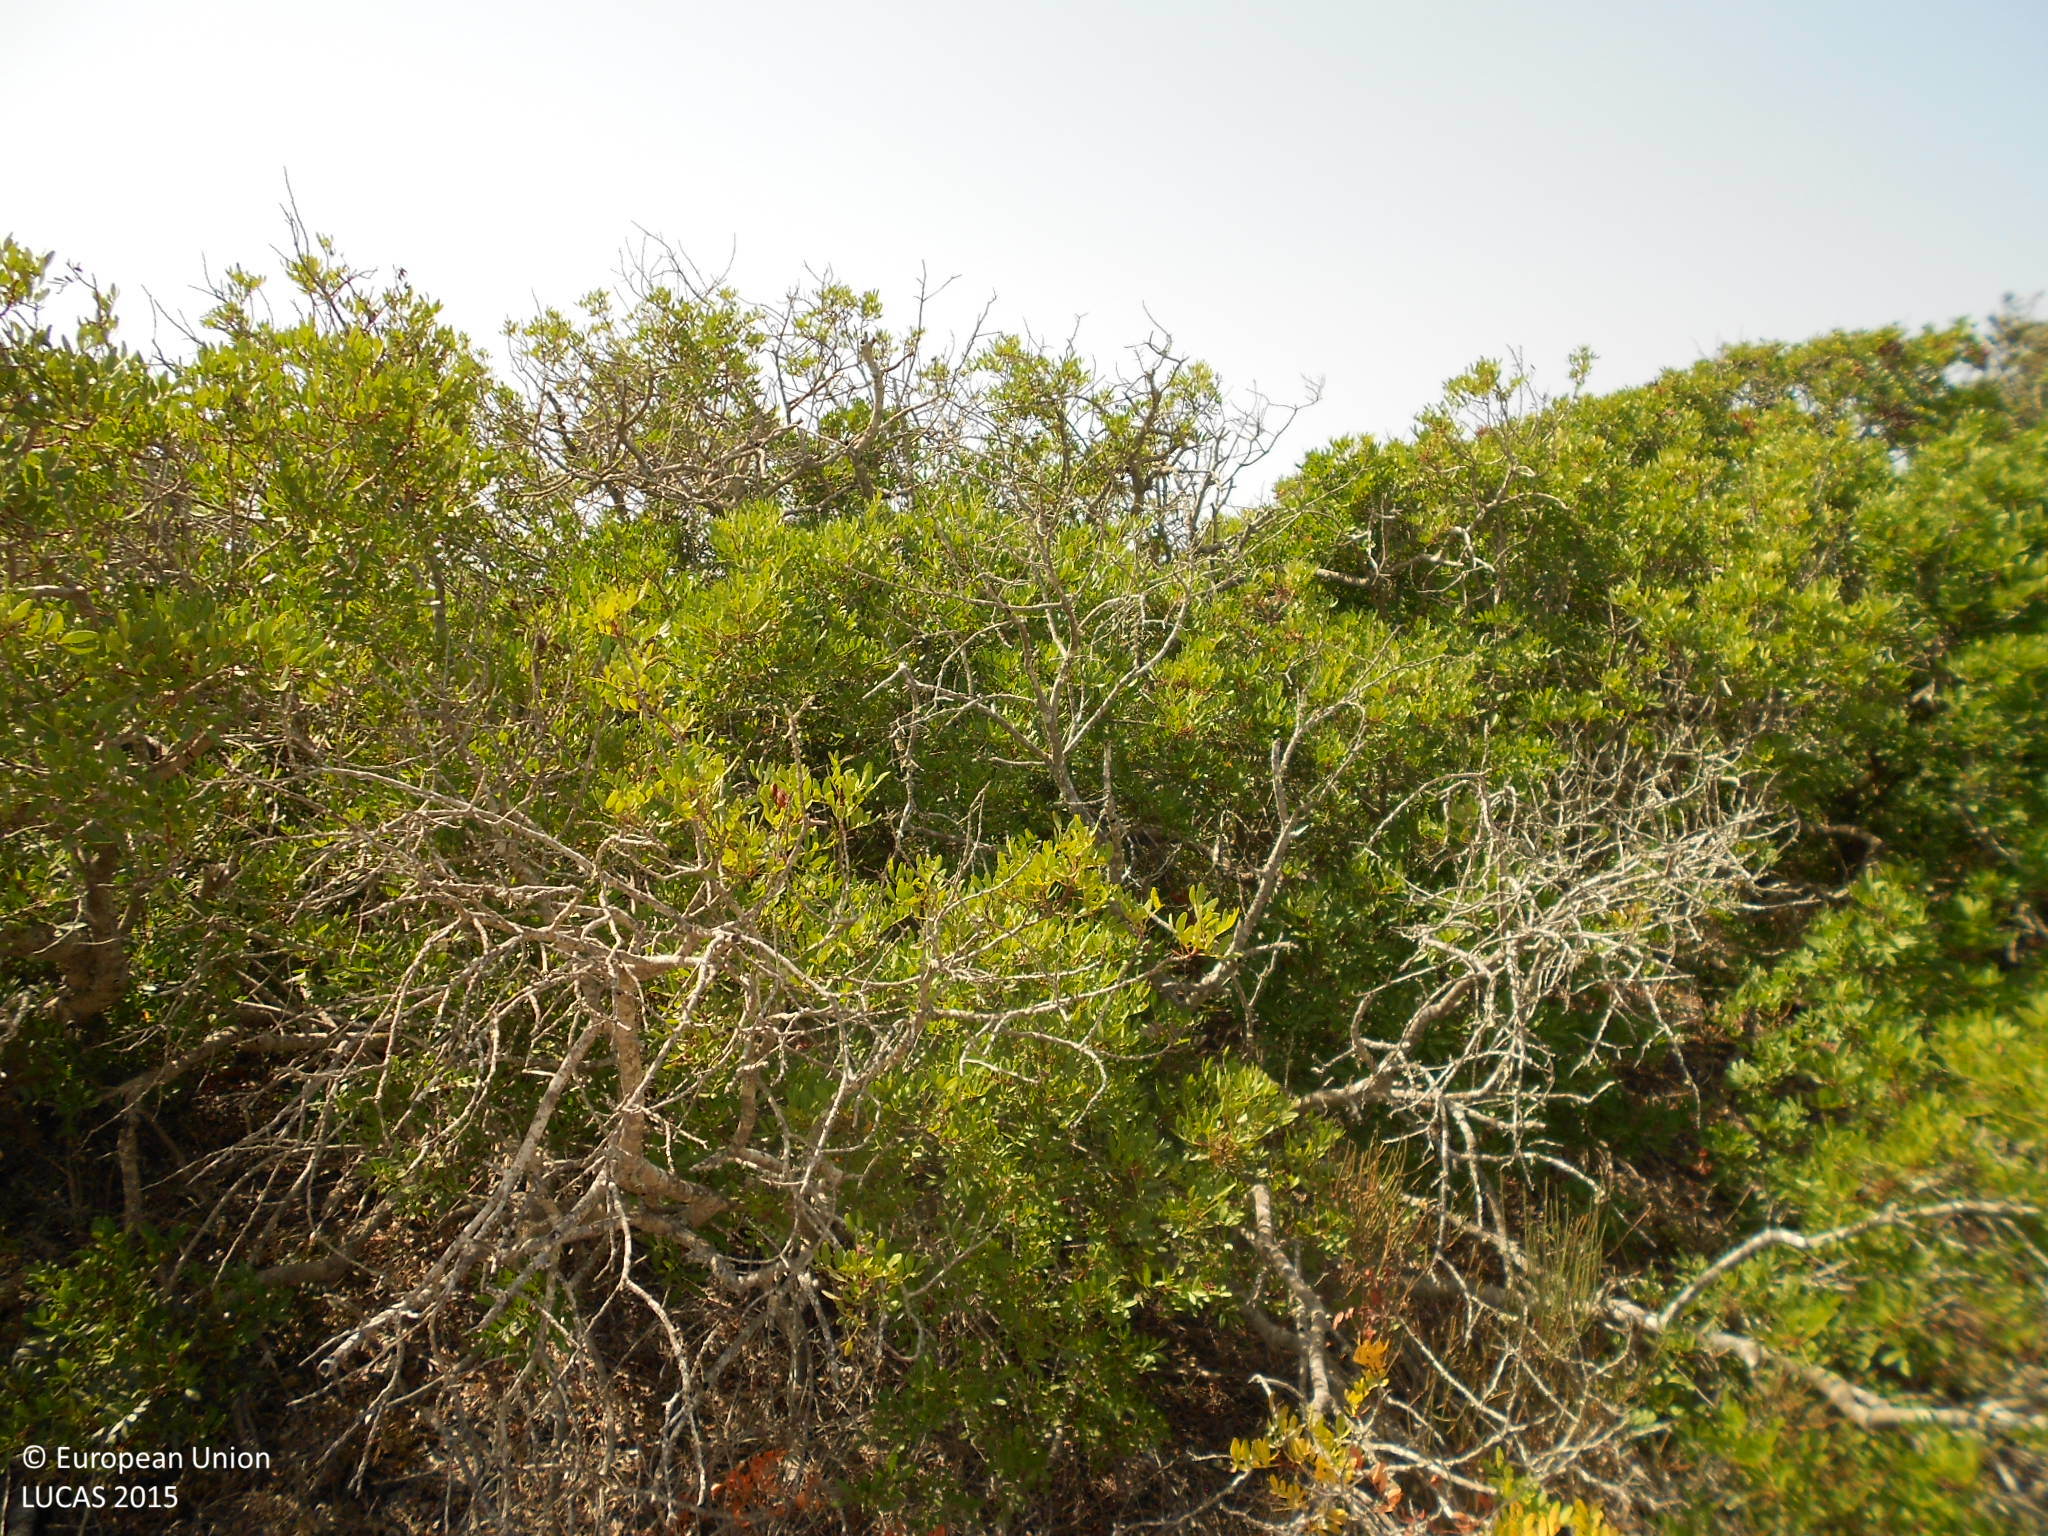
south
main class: Shrubland
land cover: Shrubland without tree cover
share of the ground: 50 - 75 %
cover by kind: shrubs 60 %, unconsolidated bare surface 40 %
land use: Semi-natural and natural areas not in use
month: August
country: ES
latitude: 36.6906
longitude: -2.6995
